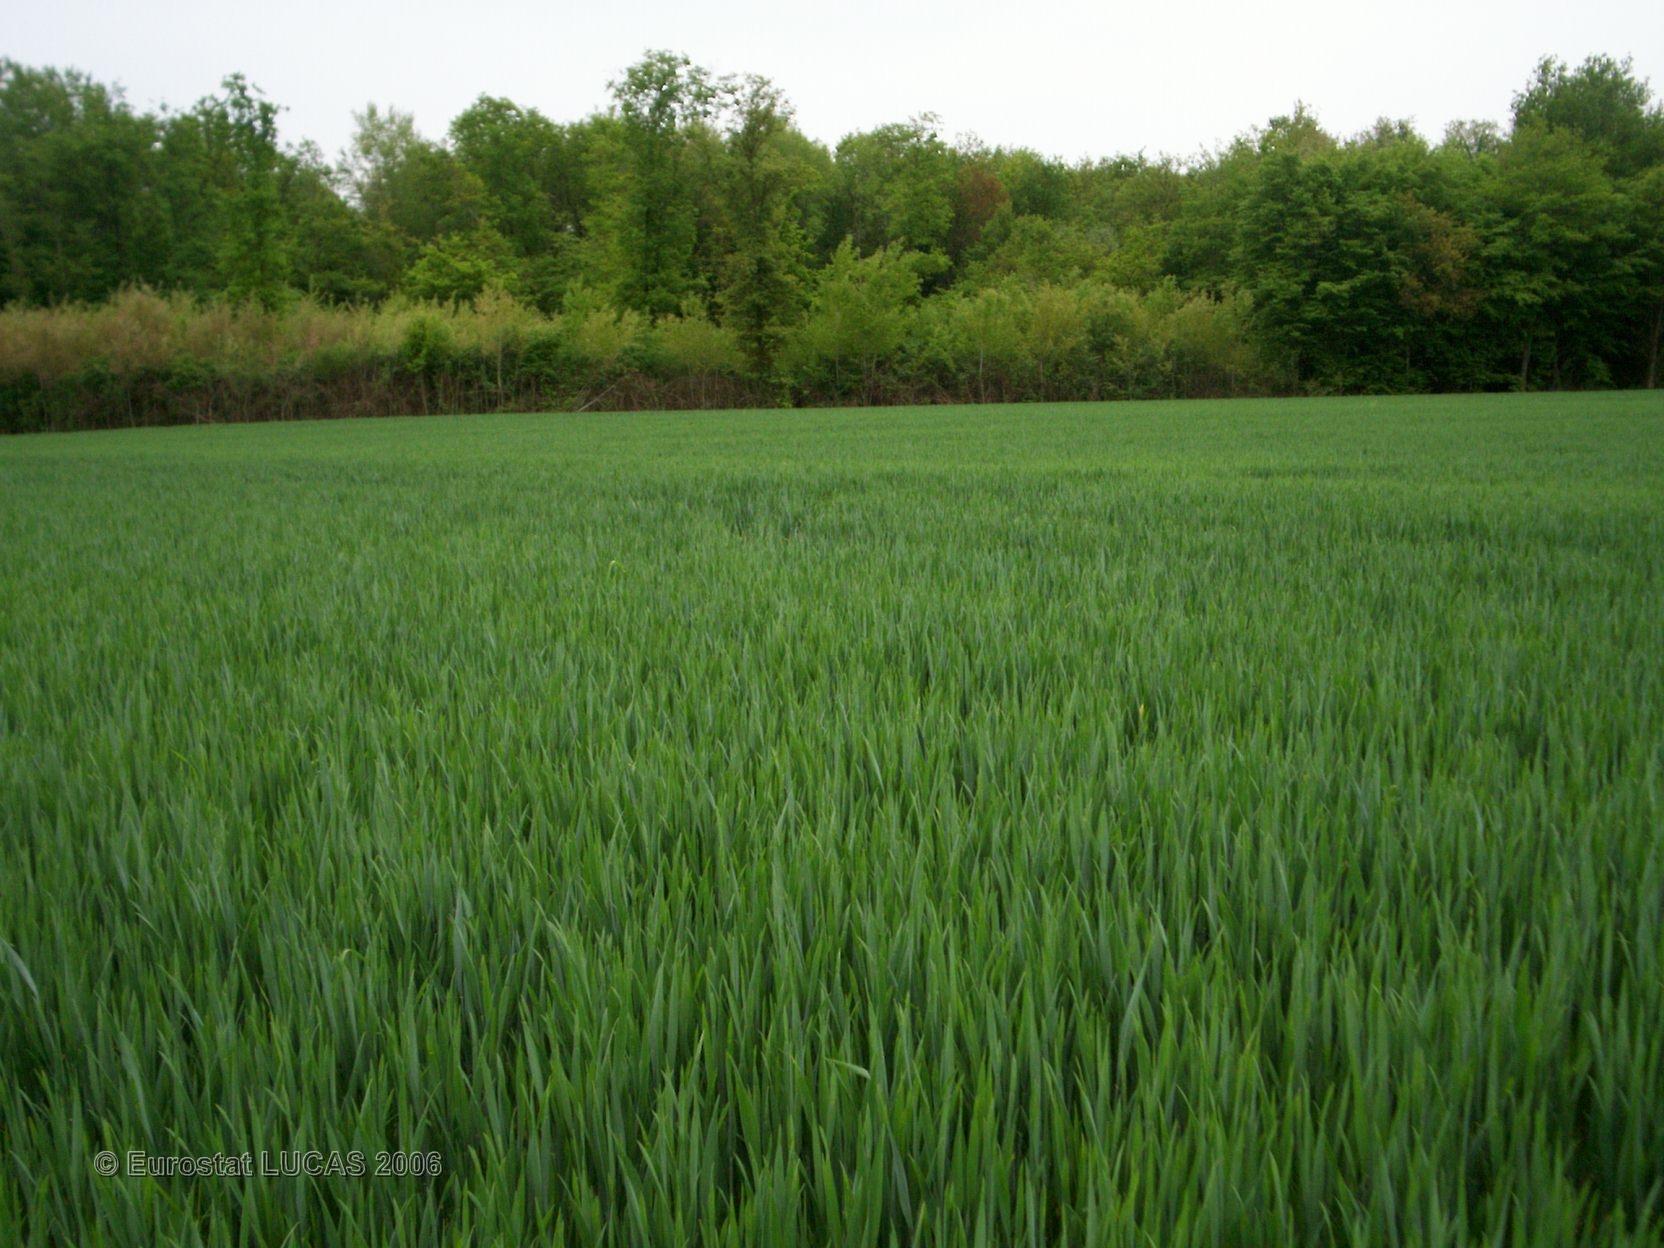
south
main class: Grassland
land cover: Grassland without tree/shrub cover
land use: Agriculture (excluding fallow land and kitchen gardens)
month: May
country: FR
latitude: 47.5768
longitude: 0.4992
